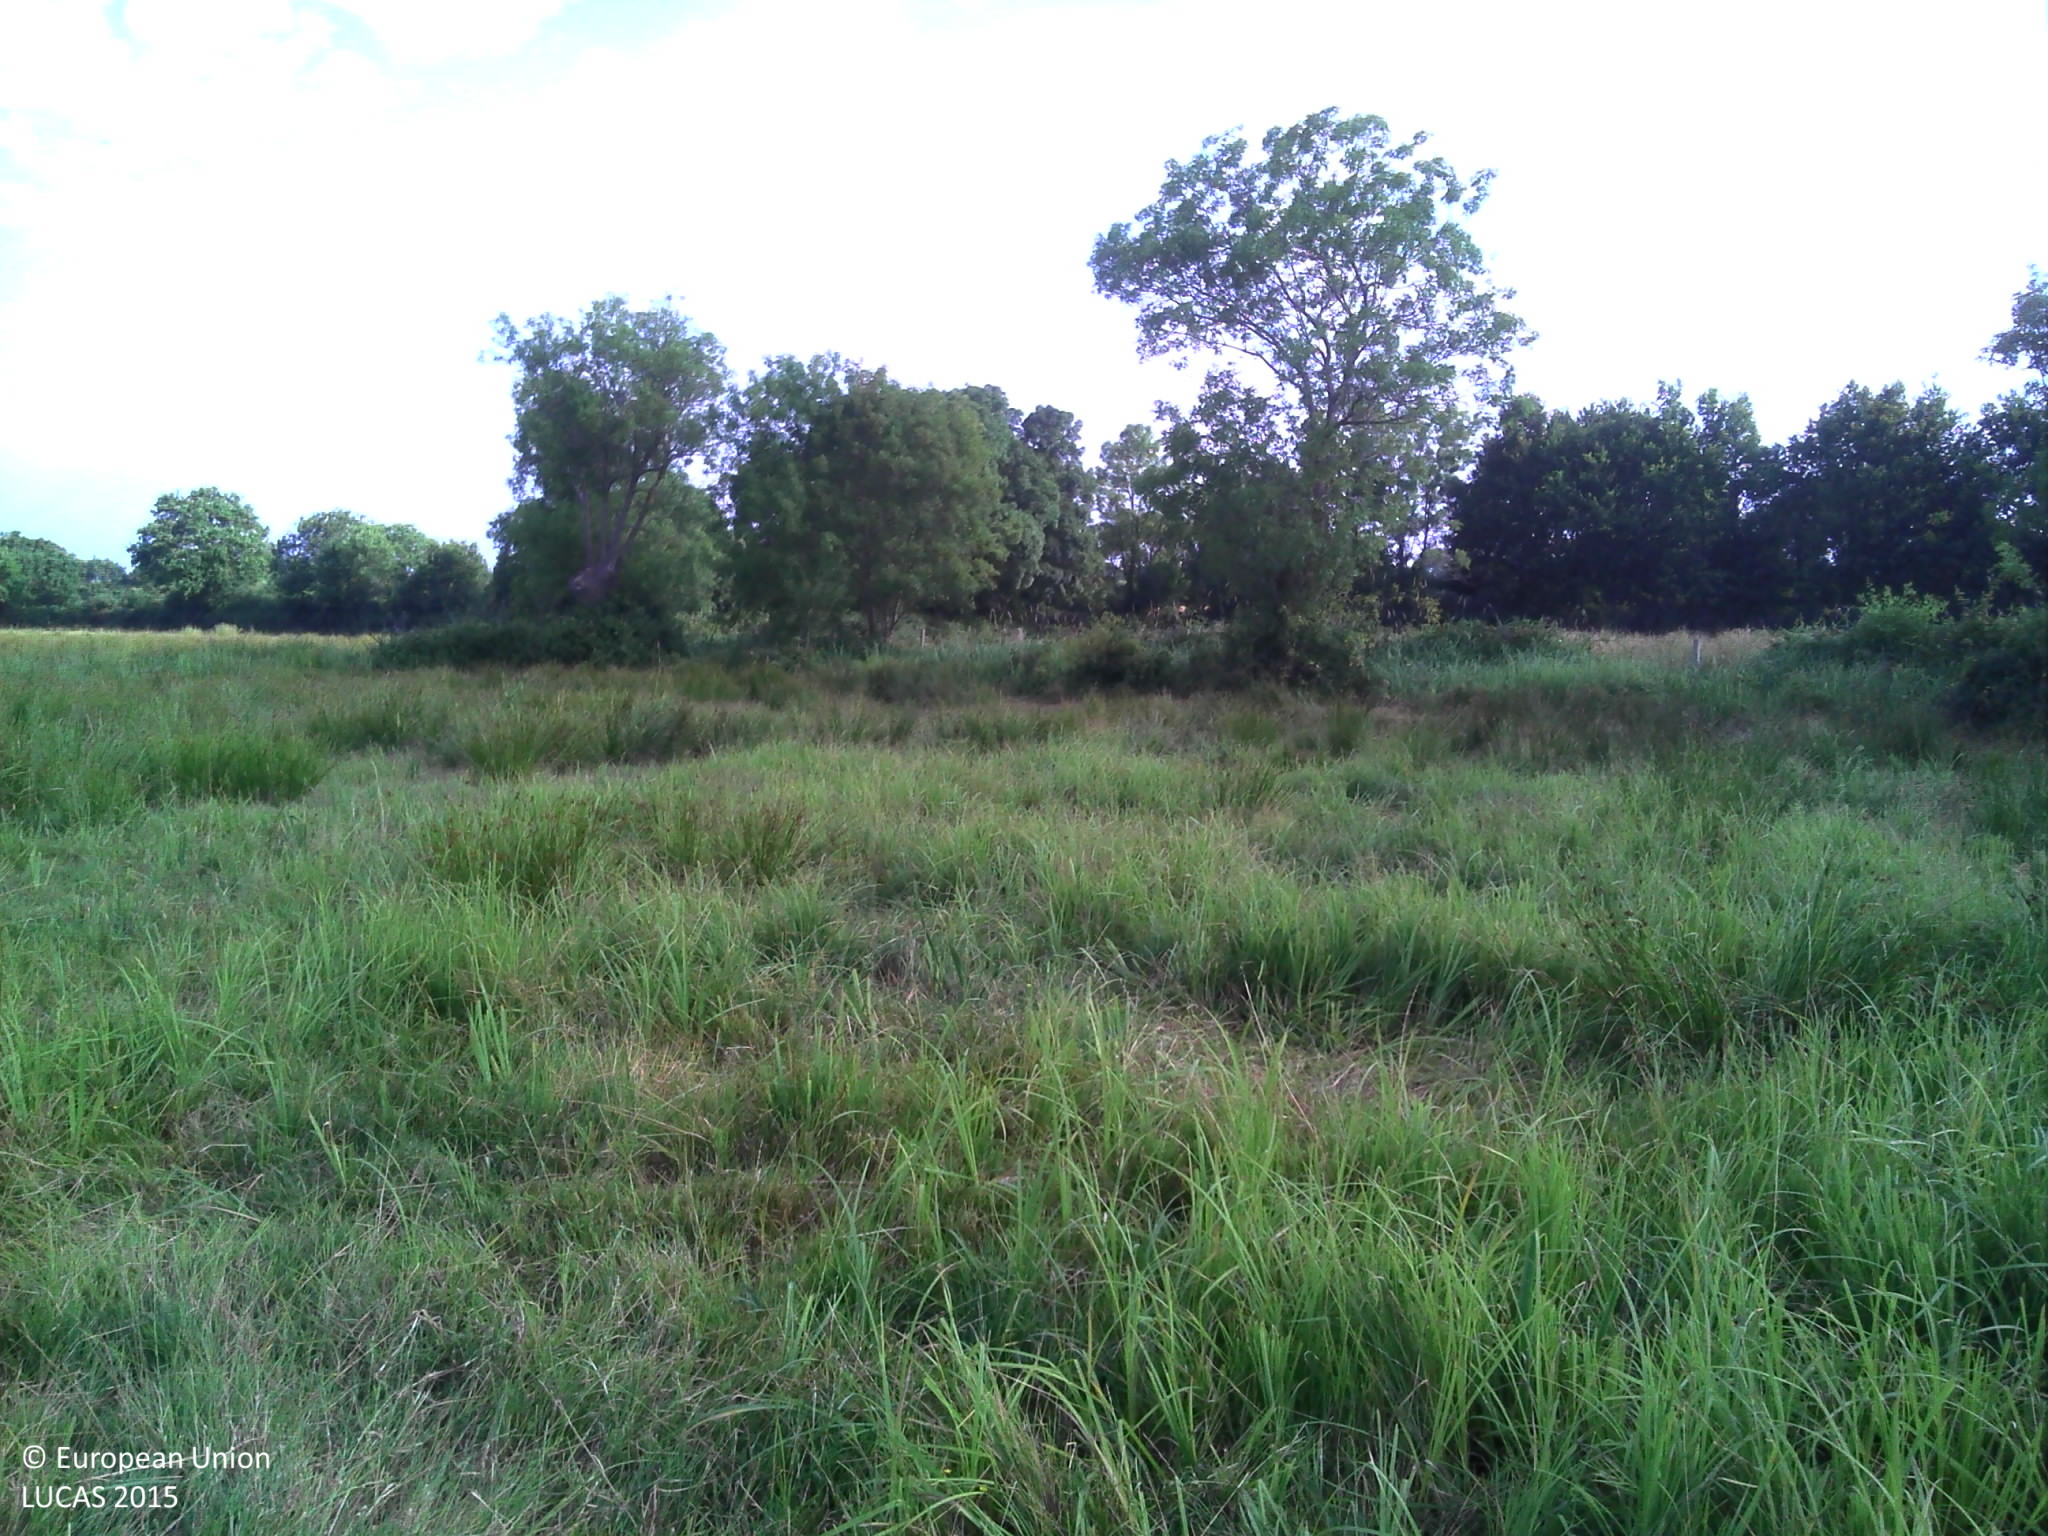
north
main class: Grassland
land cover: Grassland without tree/shrub cover
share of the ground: > 75 %
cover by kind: herbaceous plants 100 %
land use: Agriculture (excluding fallow land and kitchen gardens)
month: July
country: FR
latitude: 47.2903
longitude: -1.8545
